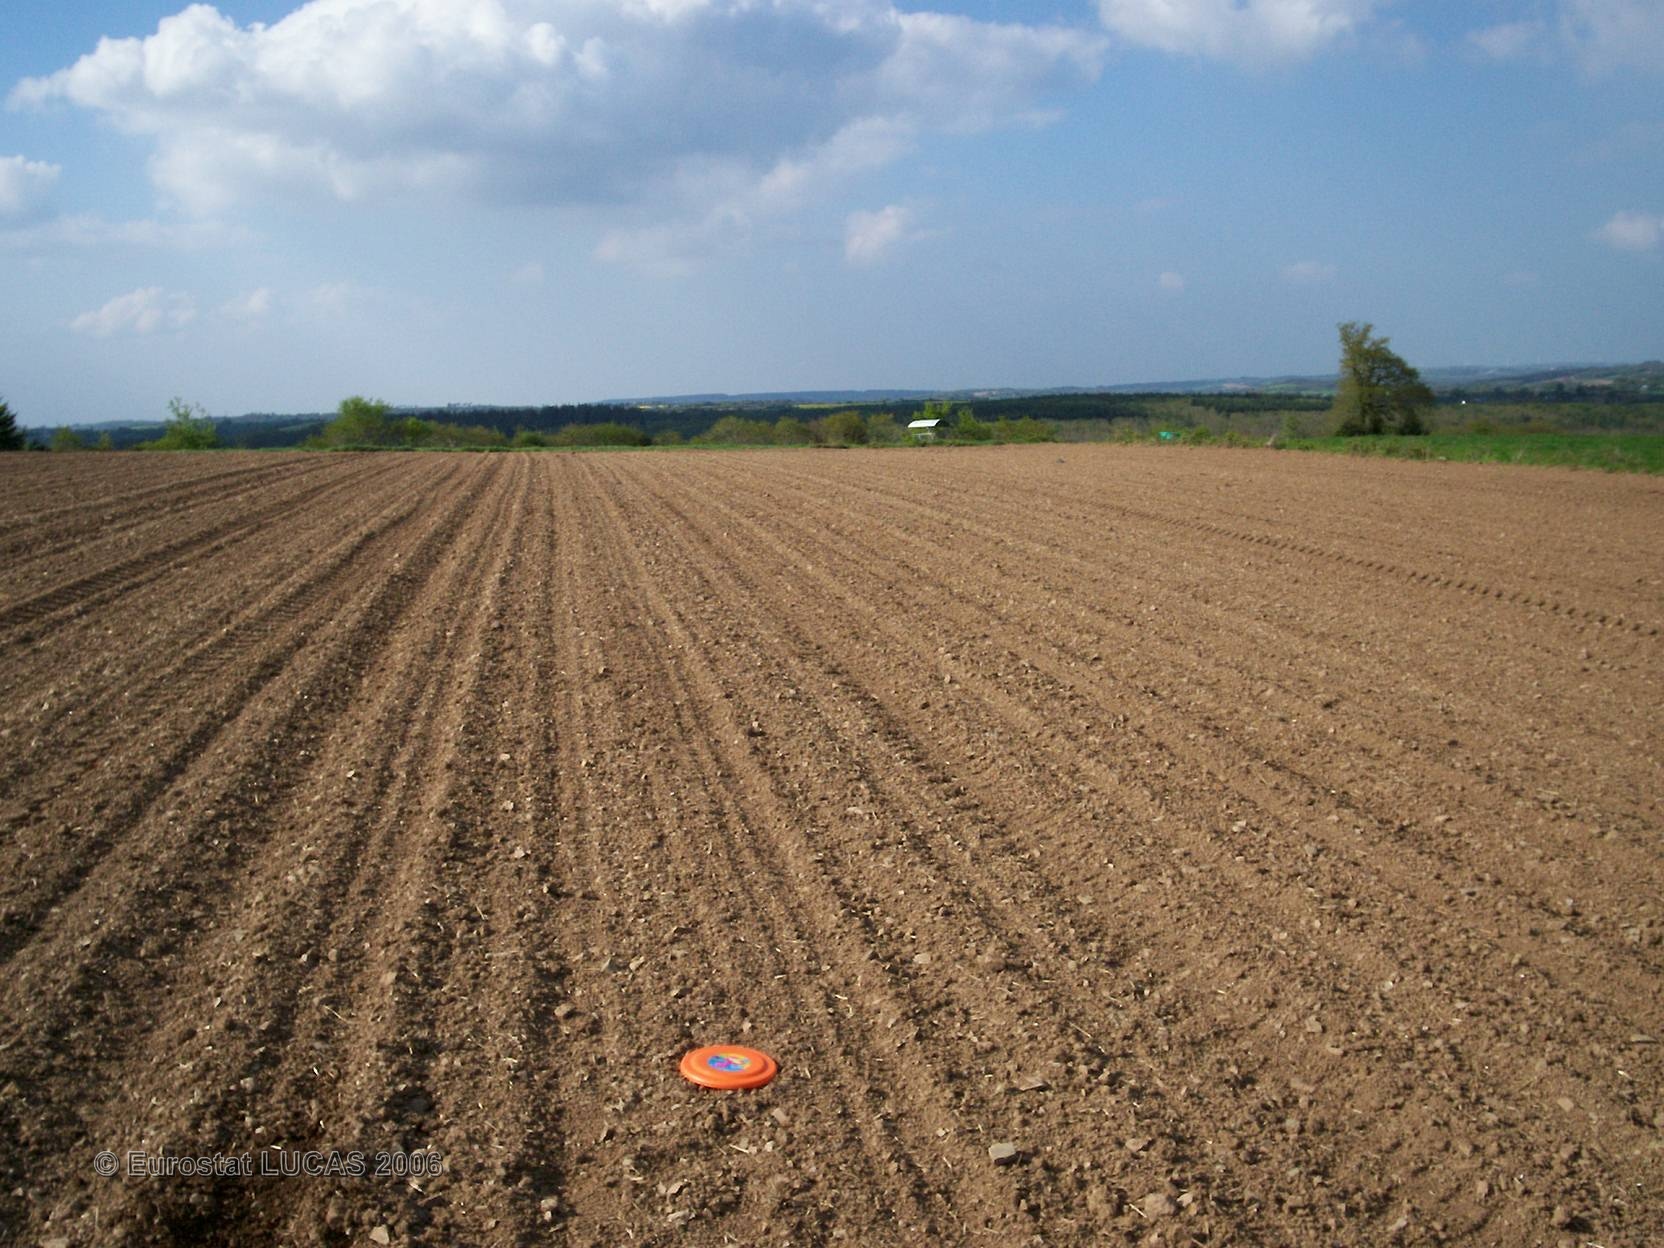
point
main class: Bare land
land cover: Bare land
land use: Agriculture (excluding fallow land and kitchen gardens)
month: May
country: FR
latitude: 48.3766
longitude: -3.6222
